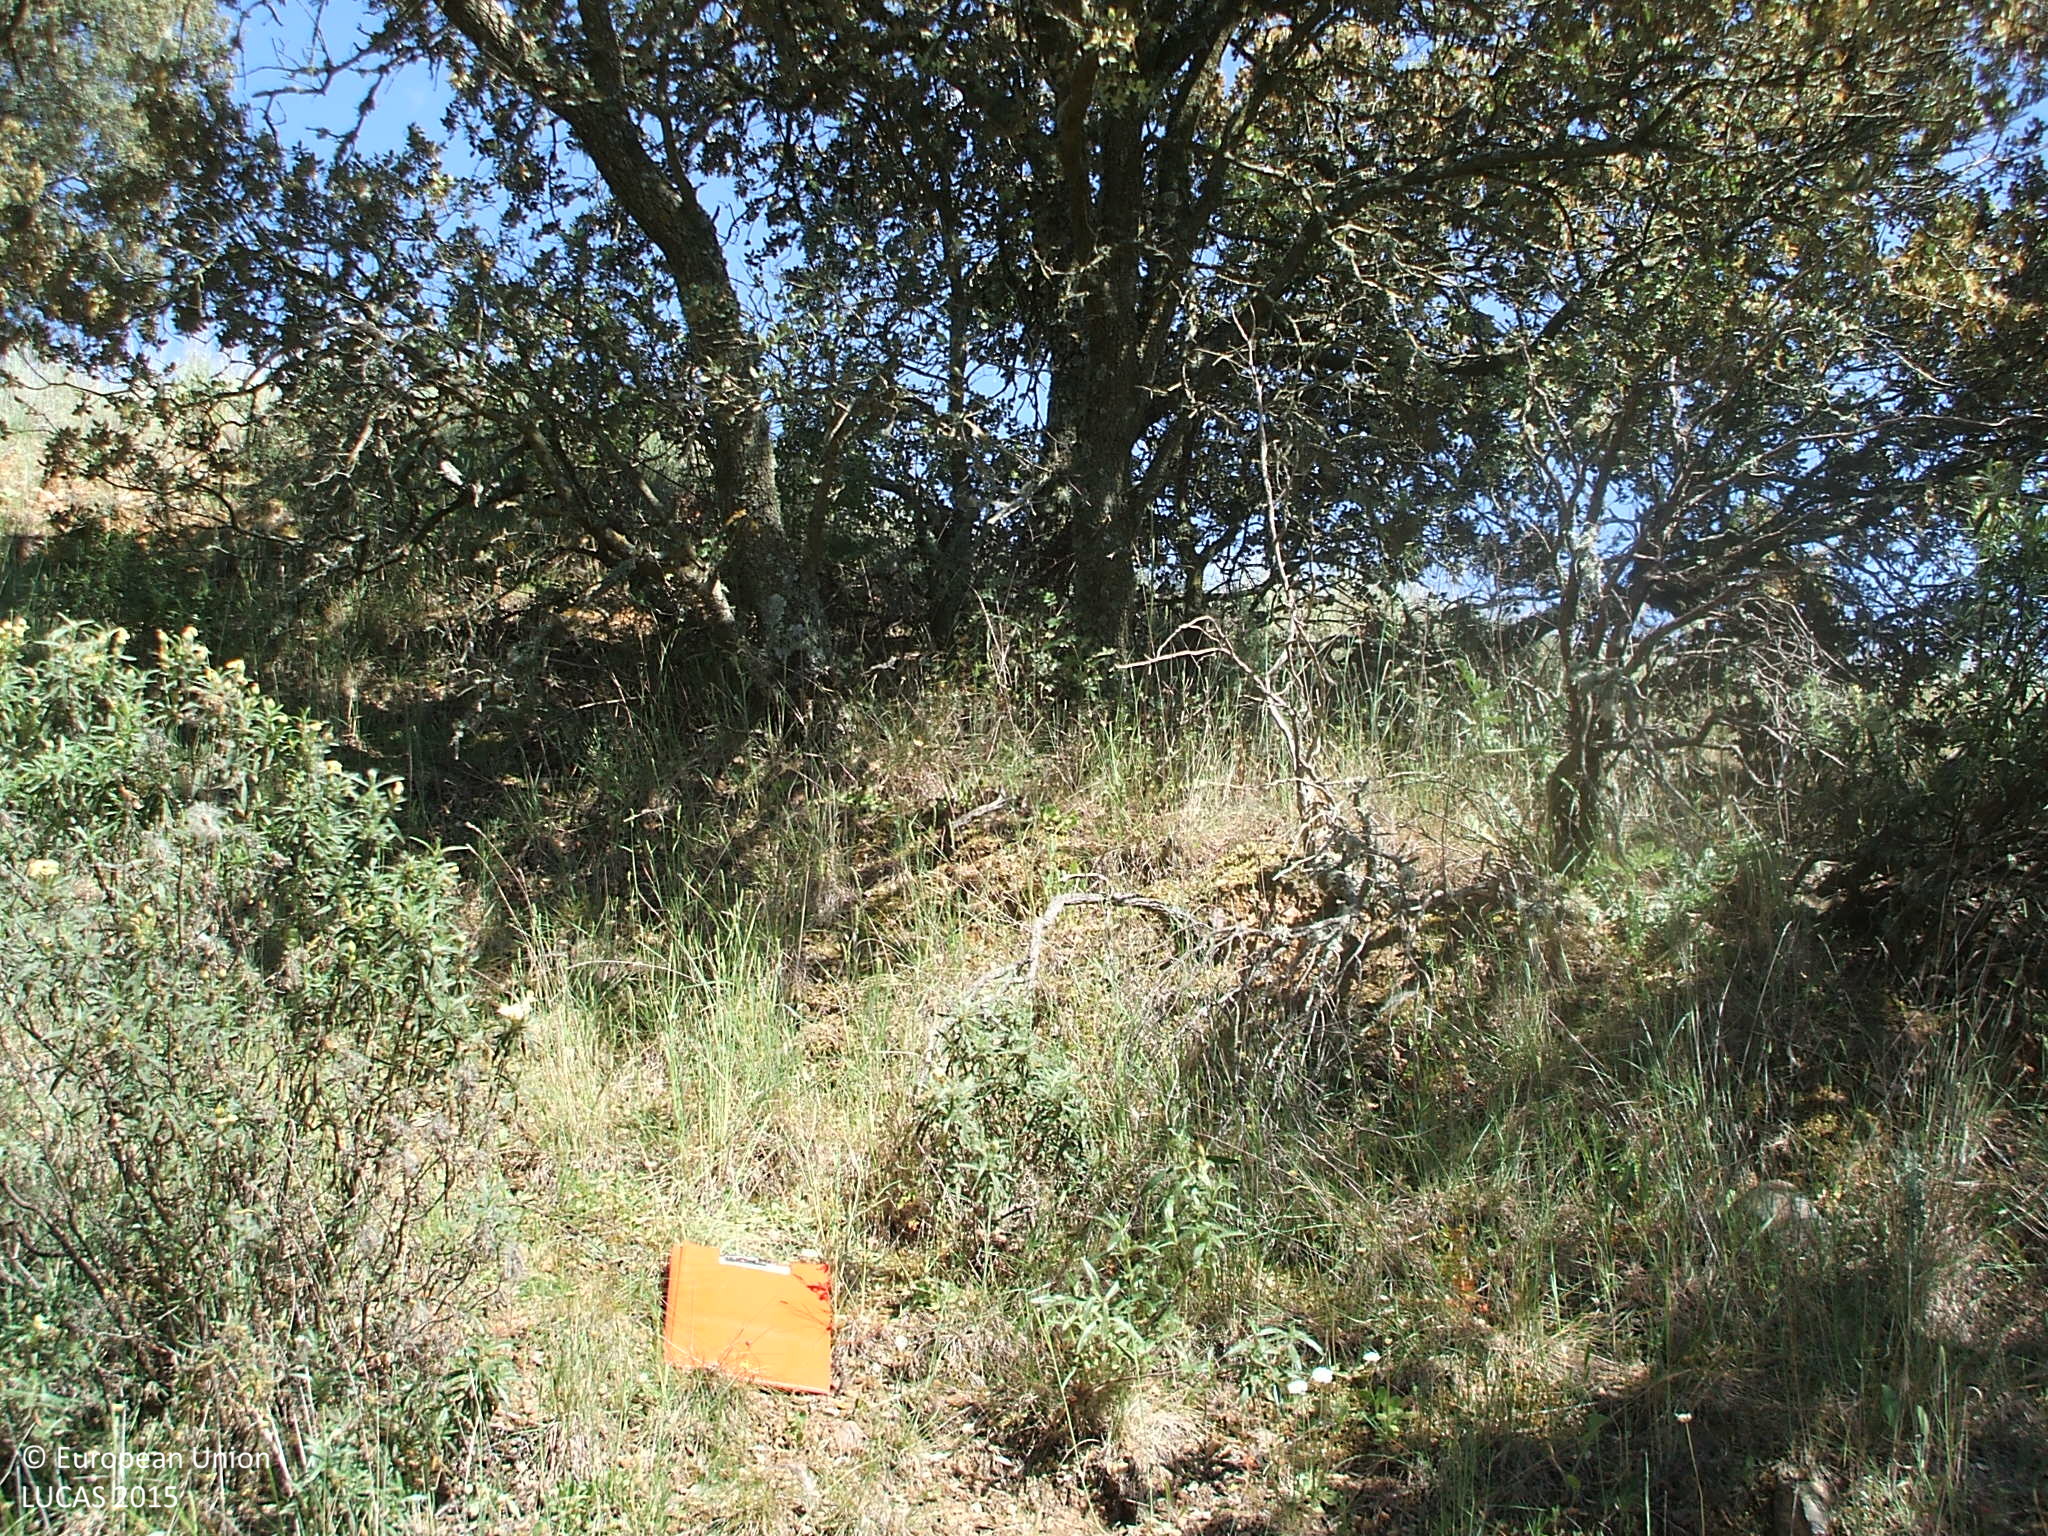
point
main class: Woodland
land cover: Broadleaved woodland
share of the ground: 10 - 25 %
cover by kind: shrubs 30 %, unconsolidated bare surface 30 %, broadleaved forest trees 20 %, herbaceous plants 20 %
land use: Semi-natural and natural areas not in use
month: May
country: ES
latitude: 40.9151
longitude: -3.0124
